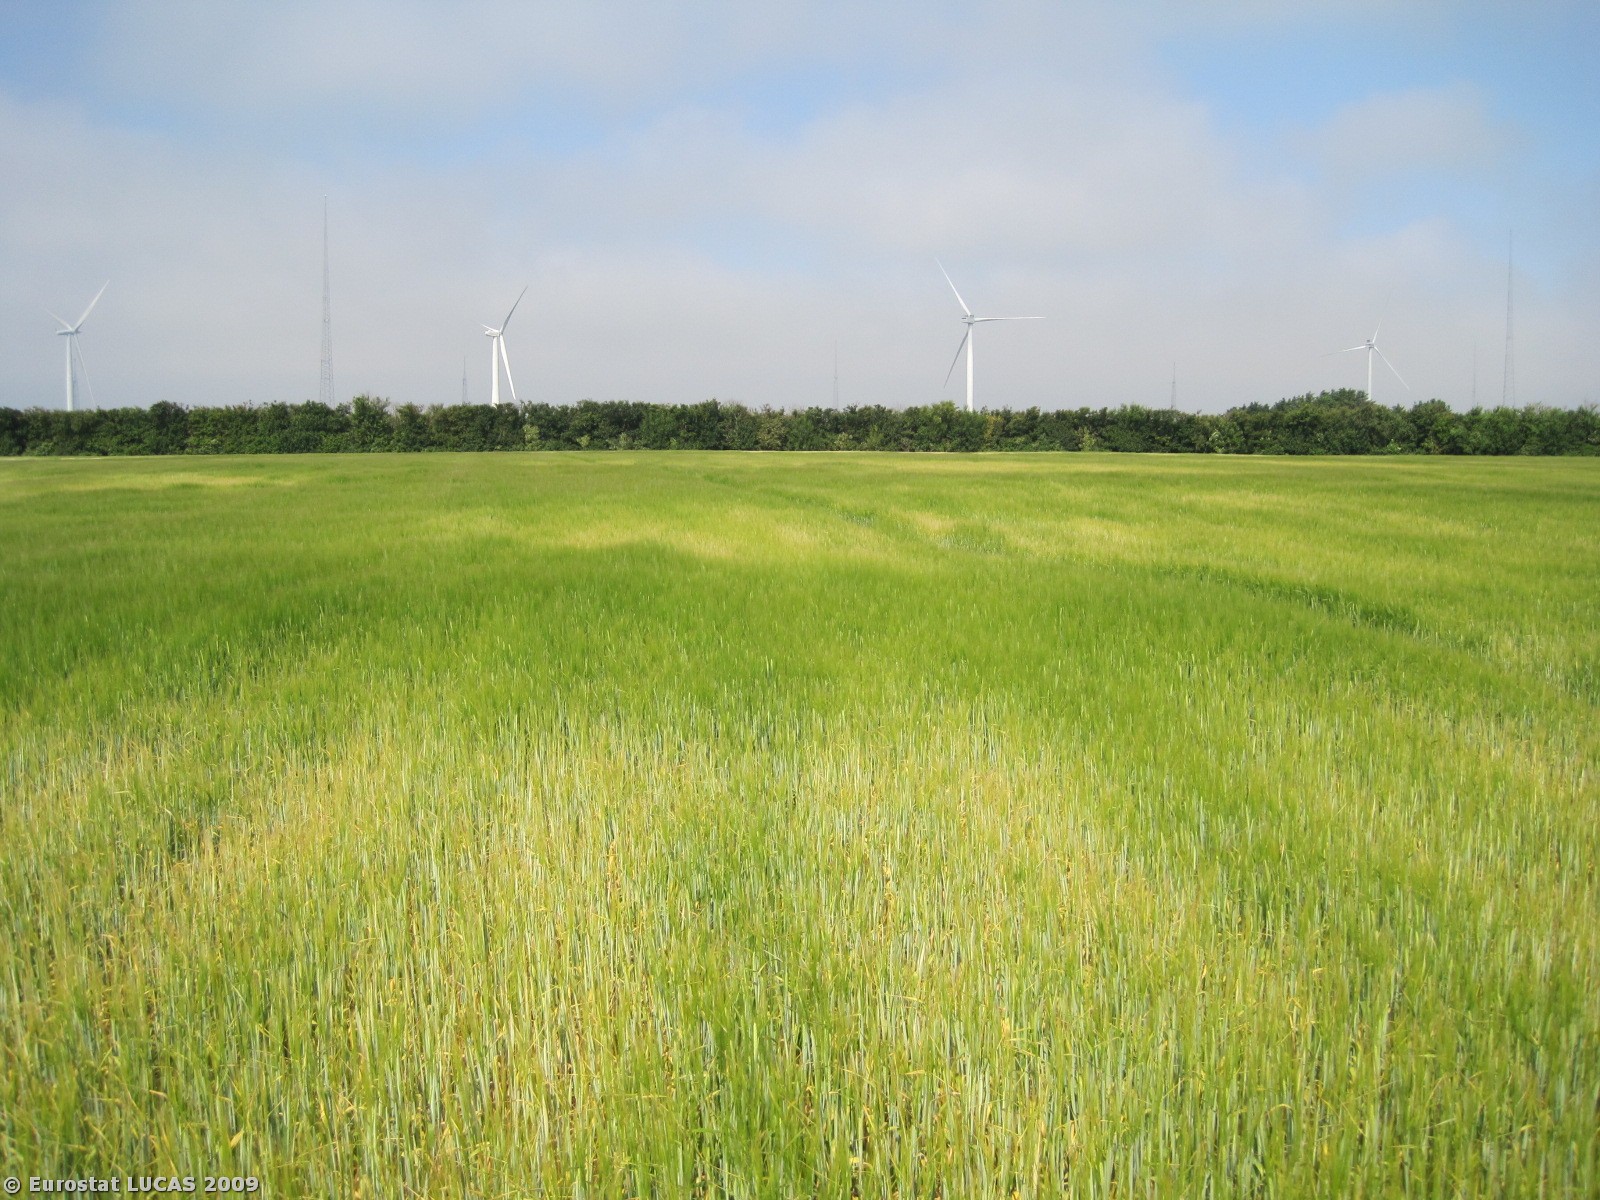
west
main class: Cropland
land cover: Barley
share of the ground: > 75 %
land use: Agriculture (excluding fallow land and kitchen gardens)
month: July
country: DK
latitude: 56.4444
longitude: 8.1691
